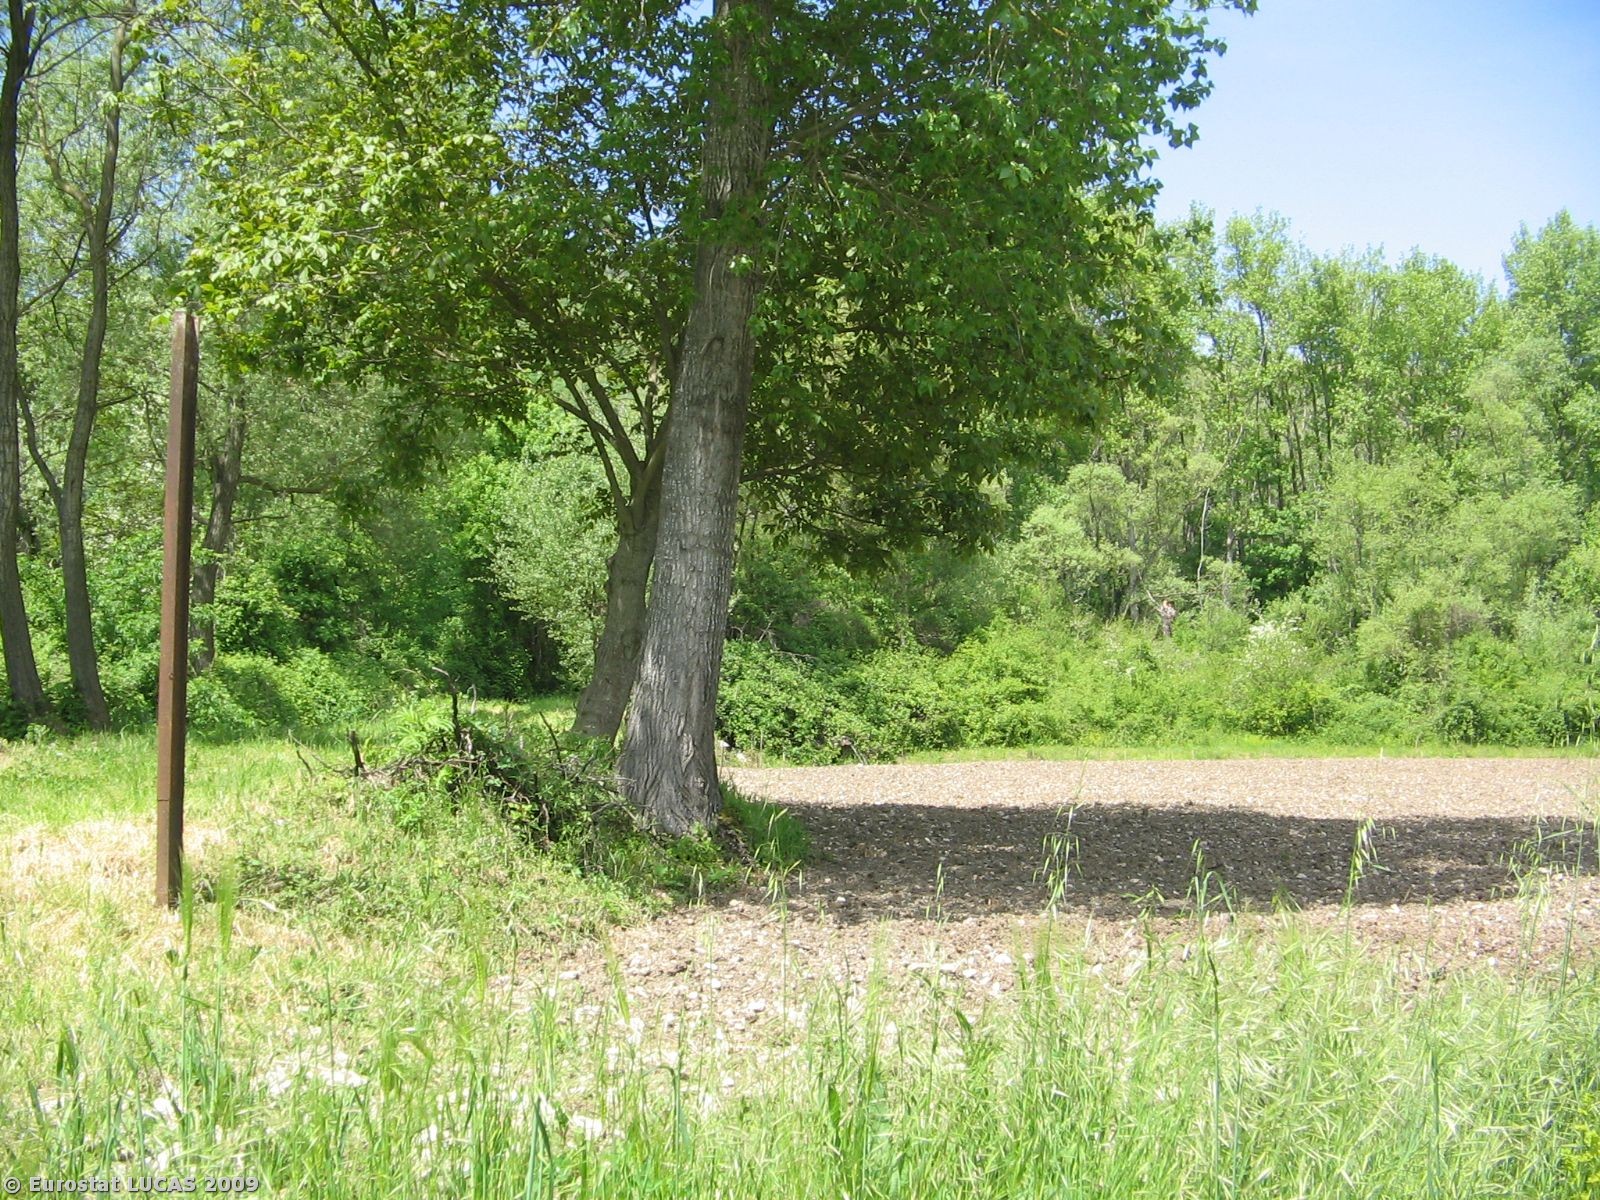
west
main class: Cropland
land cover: Temporary grasslands
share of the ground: > 75 %
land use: Agriculture (excluding fallow land and kitchen gardens)
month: May
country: IT
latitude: 41.5470
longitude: 14.3600
